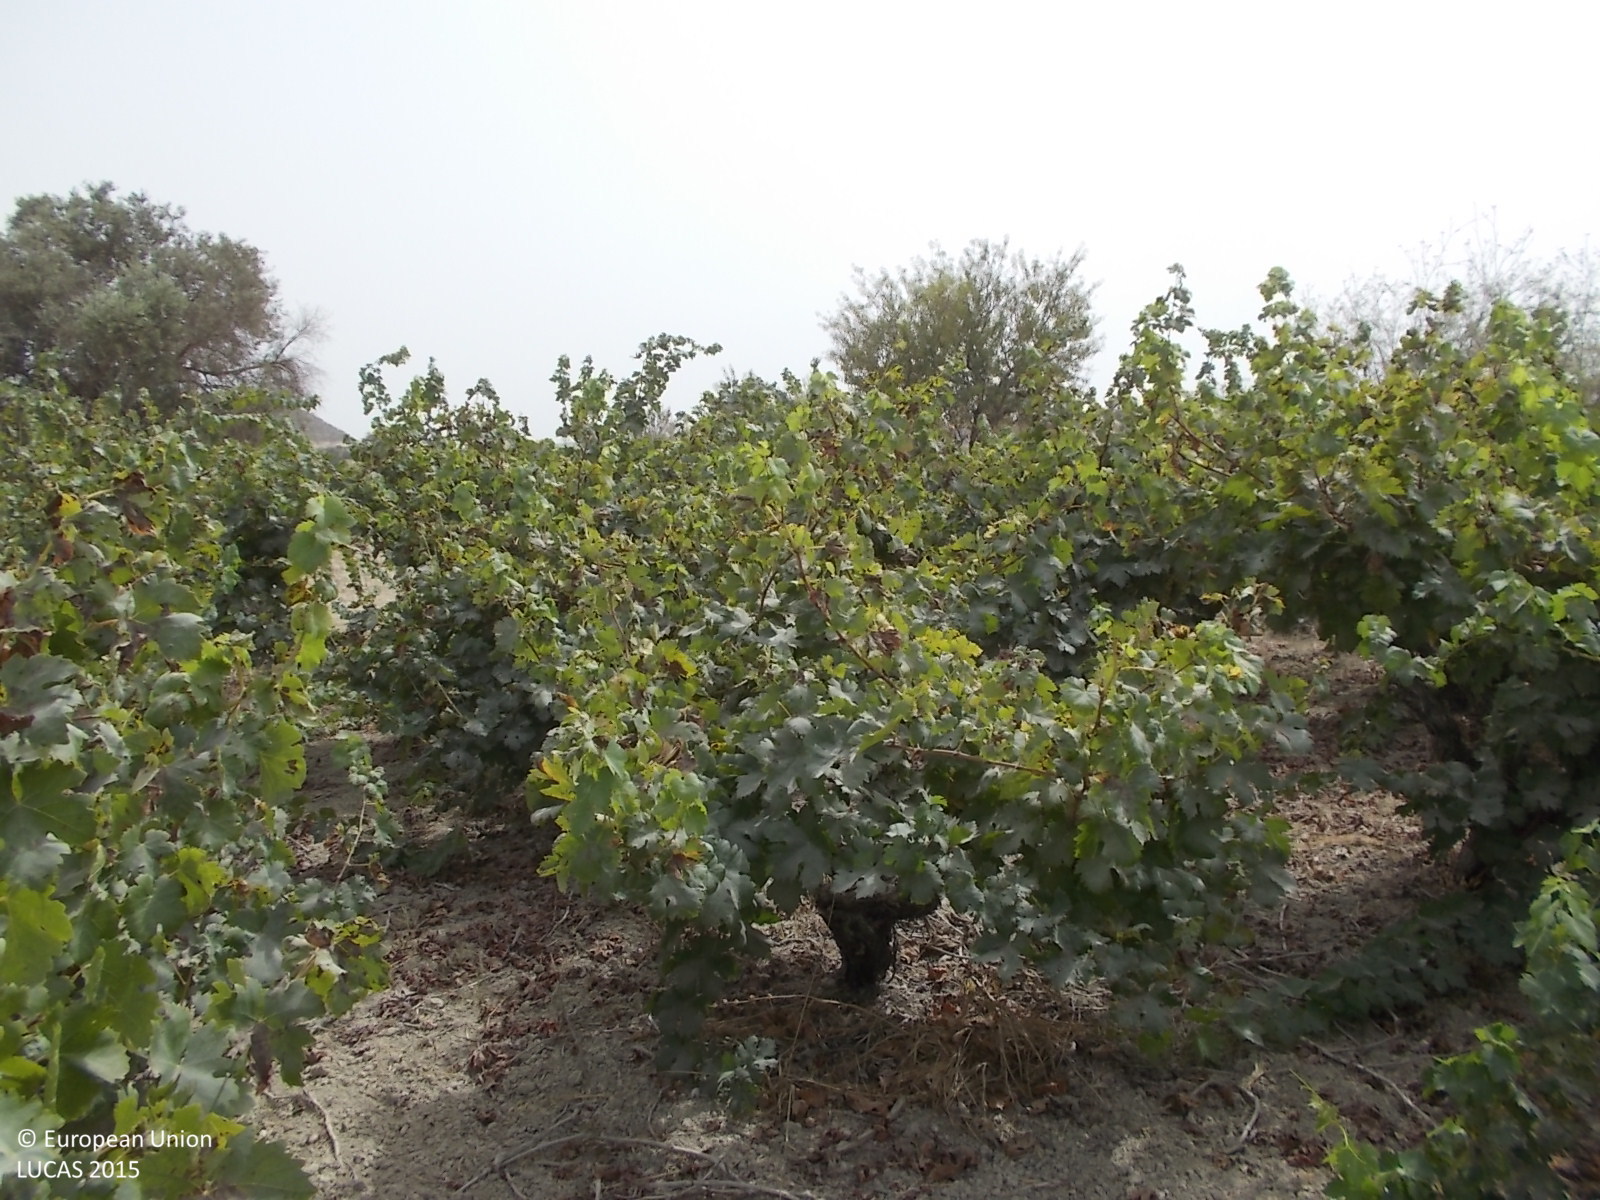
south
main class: Cropland
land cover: Vineyards
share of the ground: > 75 %
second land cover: Other bare soil
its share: > 75 %
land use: Agriculture (excluding fallow land and kitchen gardens)
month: April
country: CY
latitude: 34.8070
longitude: 33.4580
